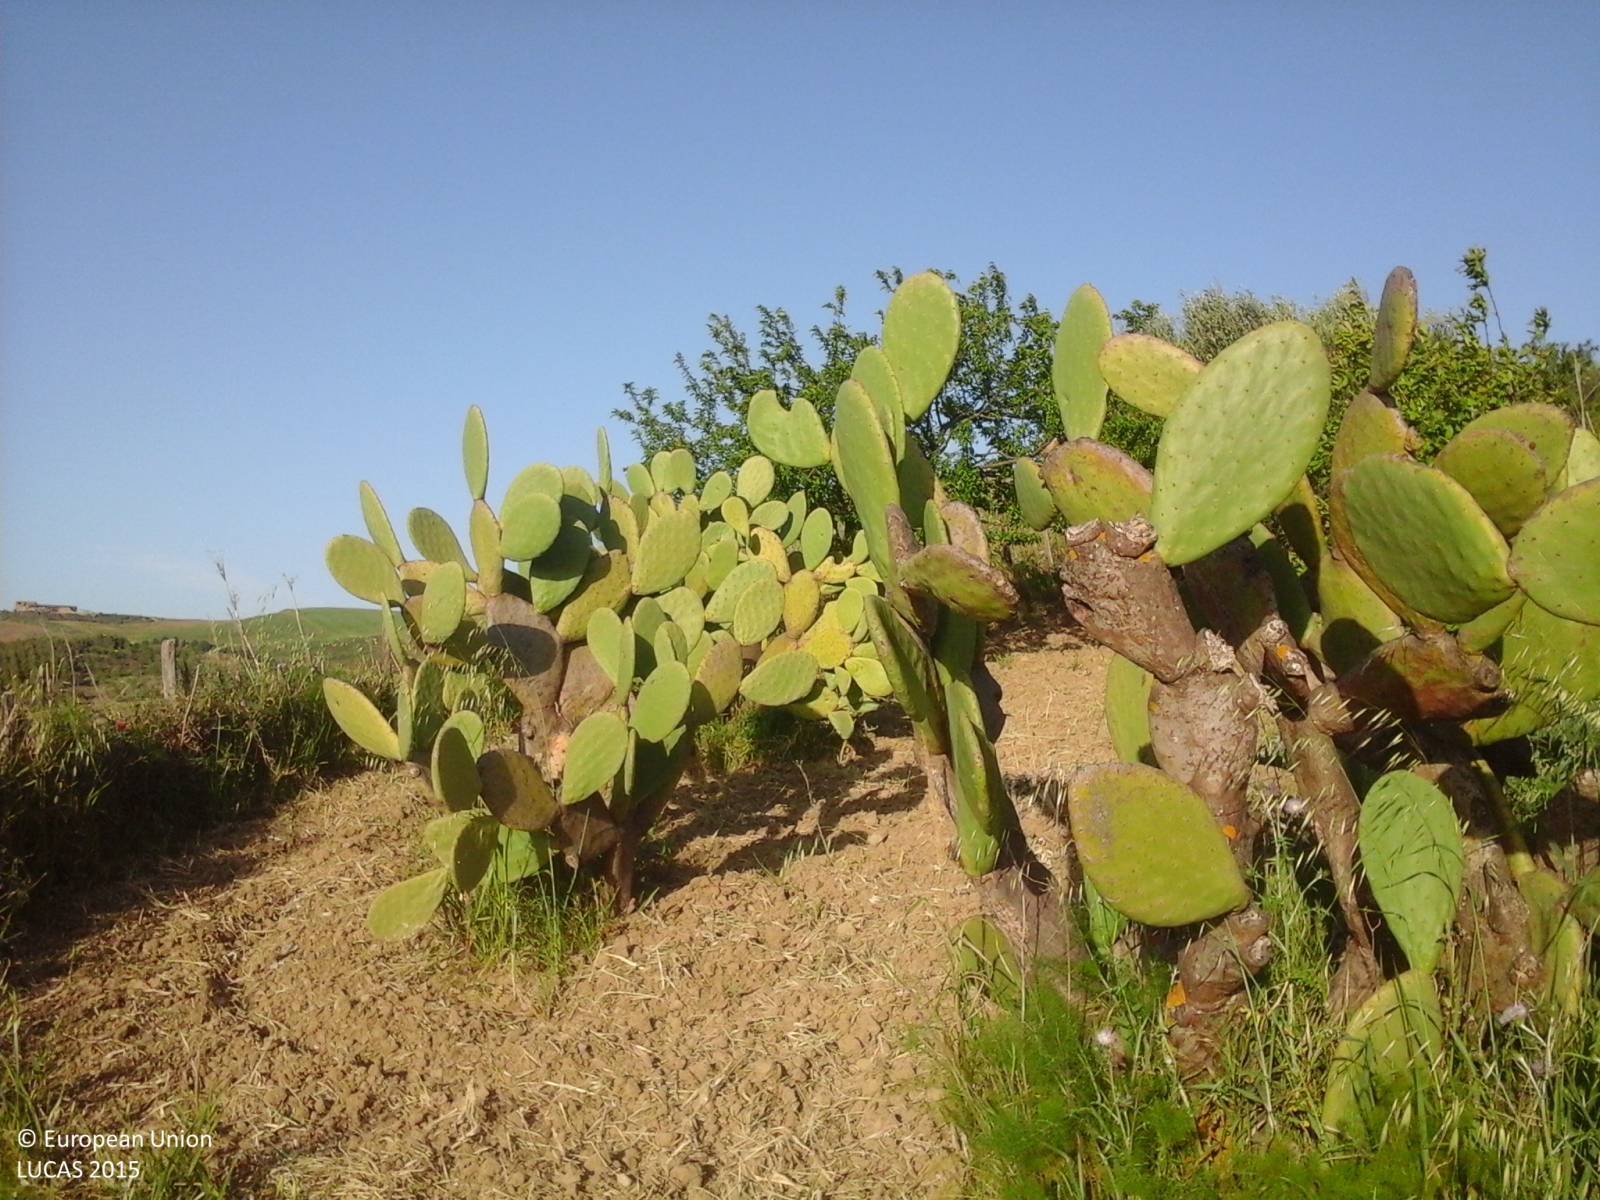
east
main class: Grassland
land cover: Grassland without tree/shrub cover
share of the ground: > 75 %
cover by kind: herbaceous plants 100 %
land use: Agriculture (excluding fallow land and kitchen gardens)
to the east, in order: Grassland without tree/shrub cover; Durum wheat
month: May
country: IT
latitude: 37.5461
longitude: 14.1908
